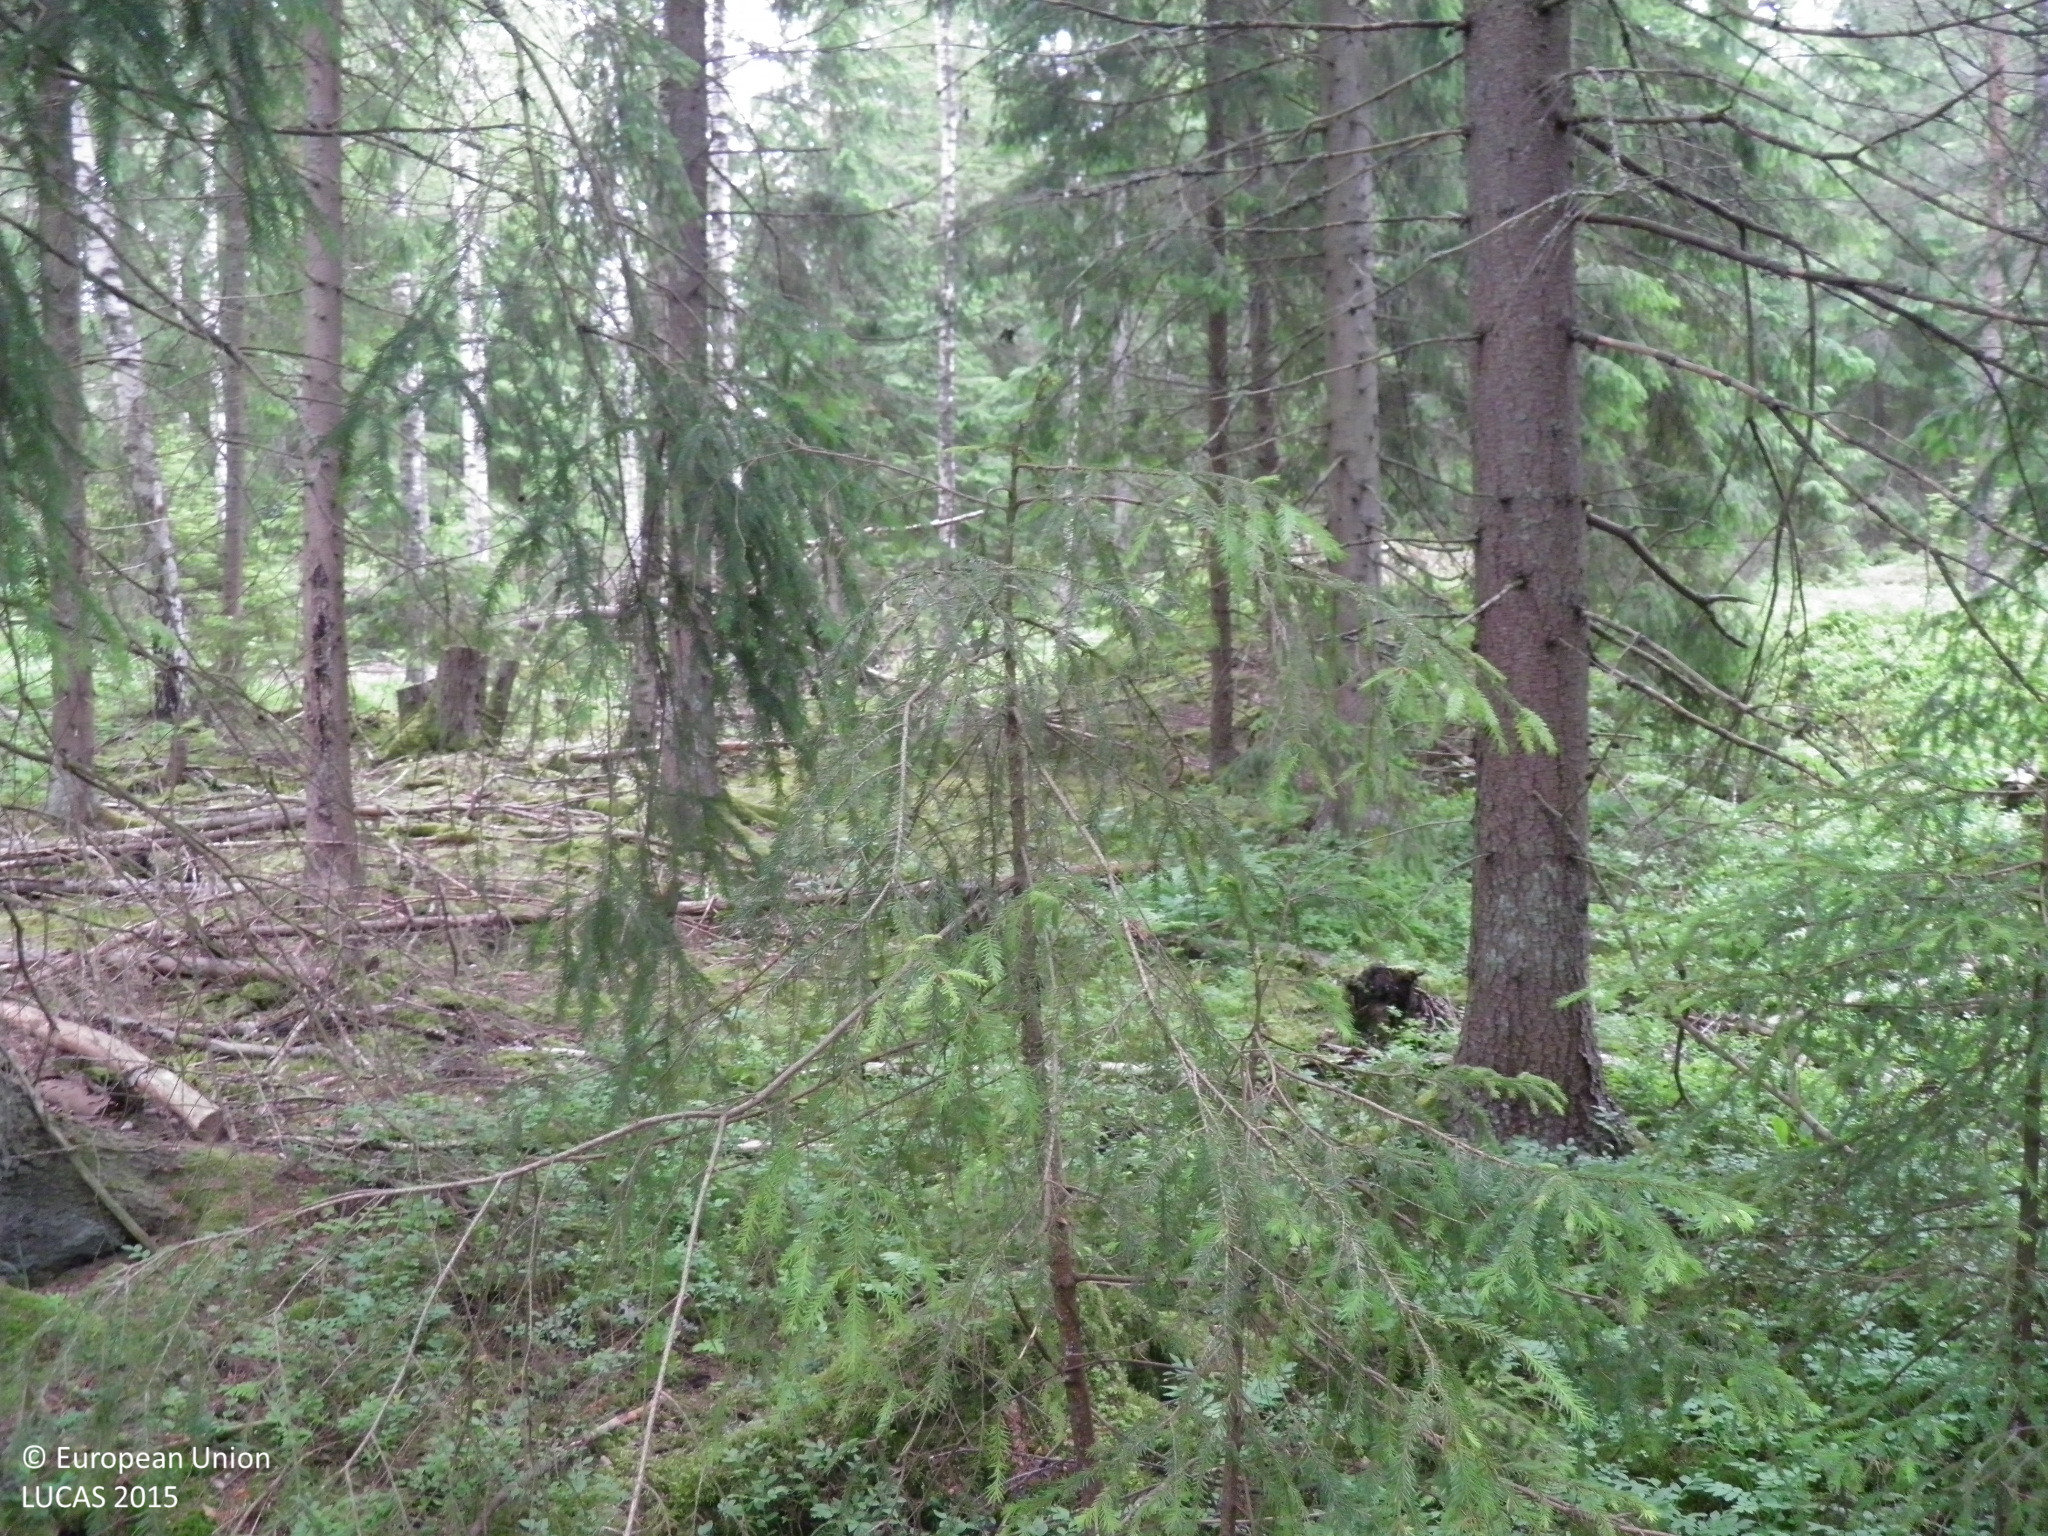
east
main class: Woodland
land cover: Spruce dominated coniferous woodland
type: hemiboreal forest and nemoral coniferous forest and mixed broadleaved-coniferous forest
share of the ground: > 75 %
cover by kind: coniferous forest trees 70 %, broadleaved forest trees 10 %, herbaceous plants 10 %, shrubs 5 %, lichens and mosses 5 %
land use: Forestry
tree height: > 5 m
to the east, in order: Spruce dominated coniferous woodland; Pine dominated coniferous woodland
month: June
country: FI
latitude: 60.2725
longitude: 22.1616
